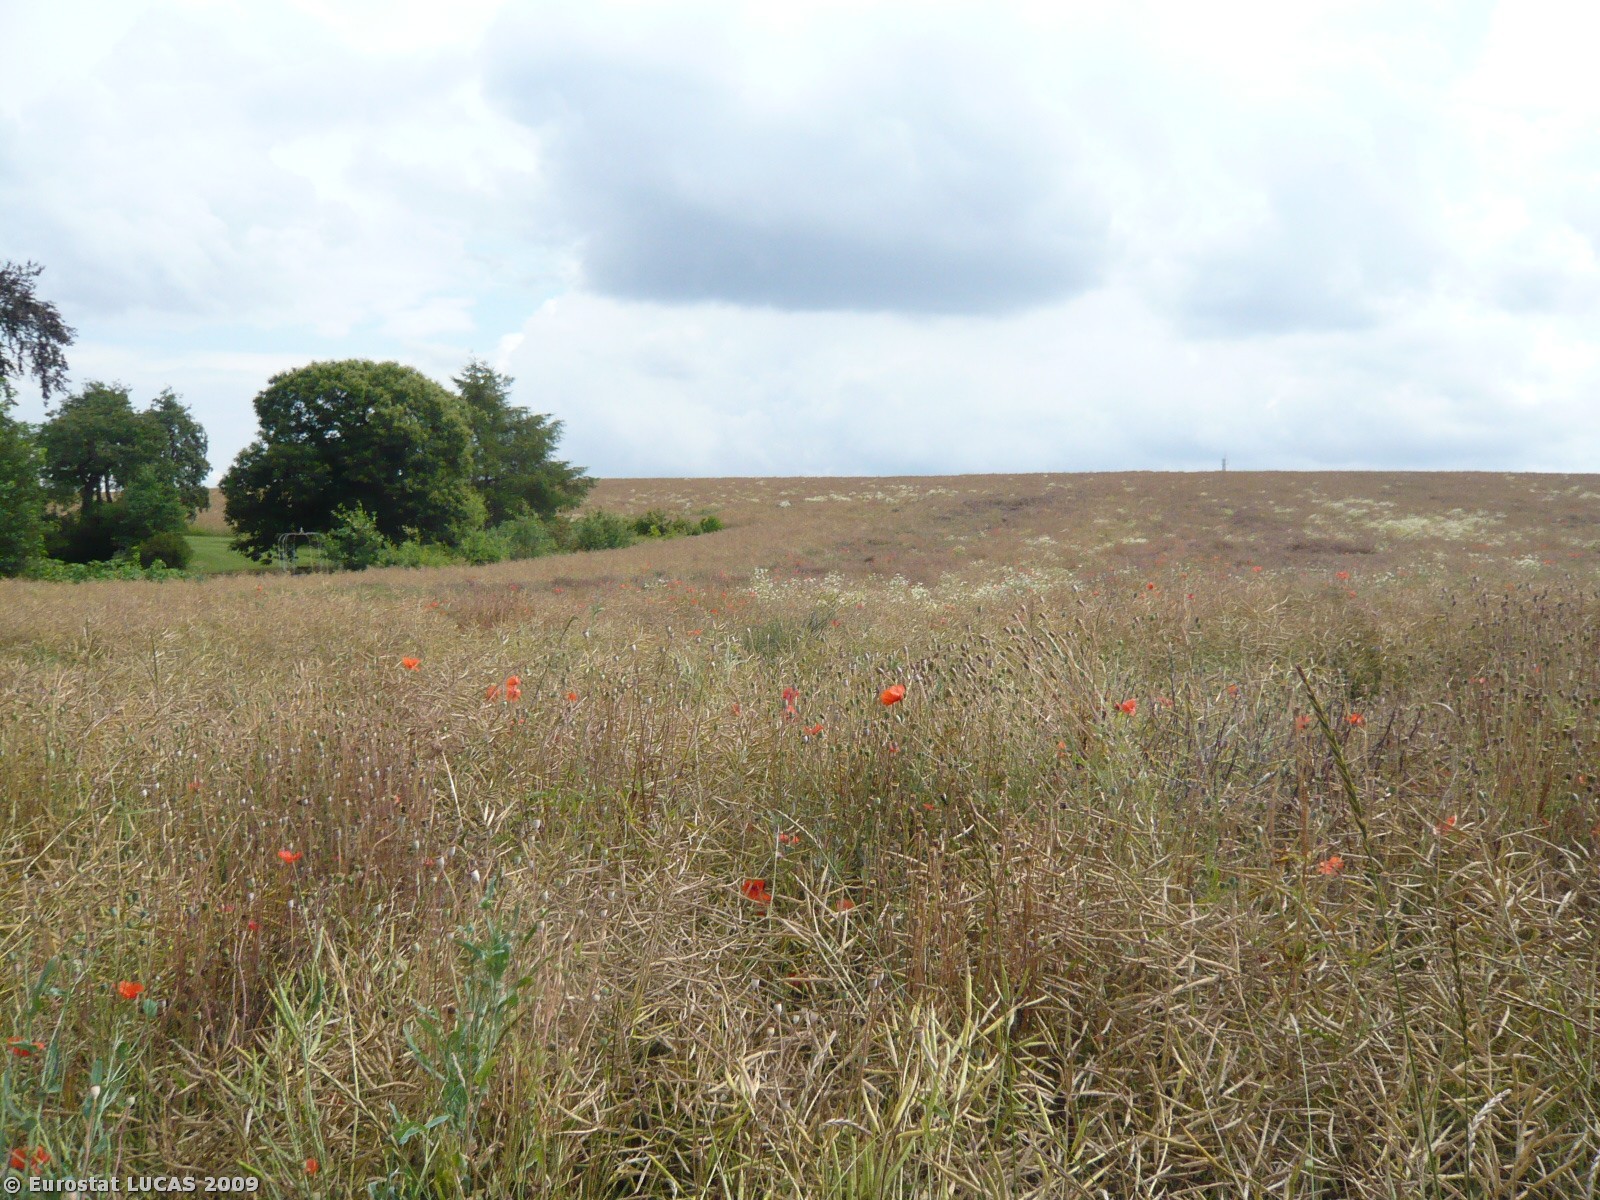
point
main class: Grassland
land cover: Grassland without tree/shrub cover
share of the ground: > 75 %
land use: Residential
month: July
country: DK
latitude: 55.8291
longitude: 12.0894
